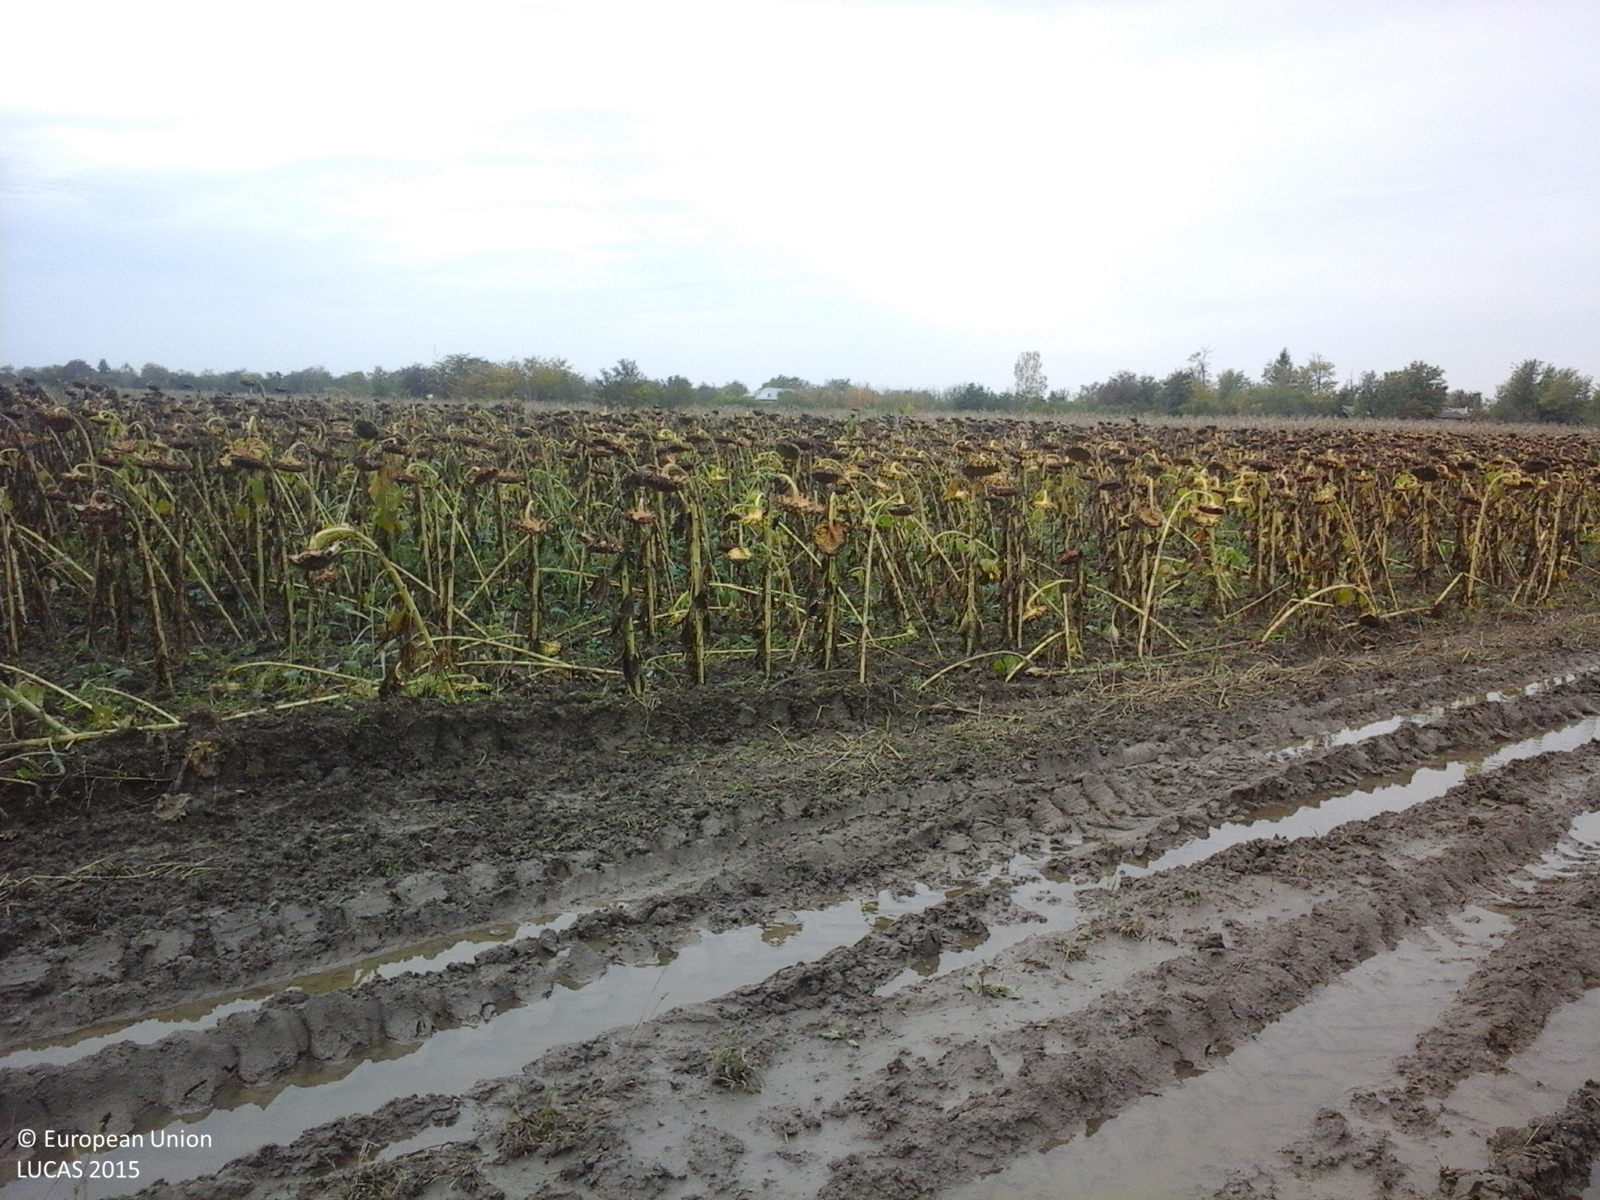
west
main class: Cropland
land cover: Sunflower
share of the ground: > 75 %
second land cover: Spontaneously vegetated surfaces
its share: 25 - 50 %
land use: Agriculture (excluding fallow land and kitchen gardens)
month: October
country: RO
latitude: 44.8810
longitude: 26.2285
